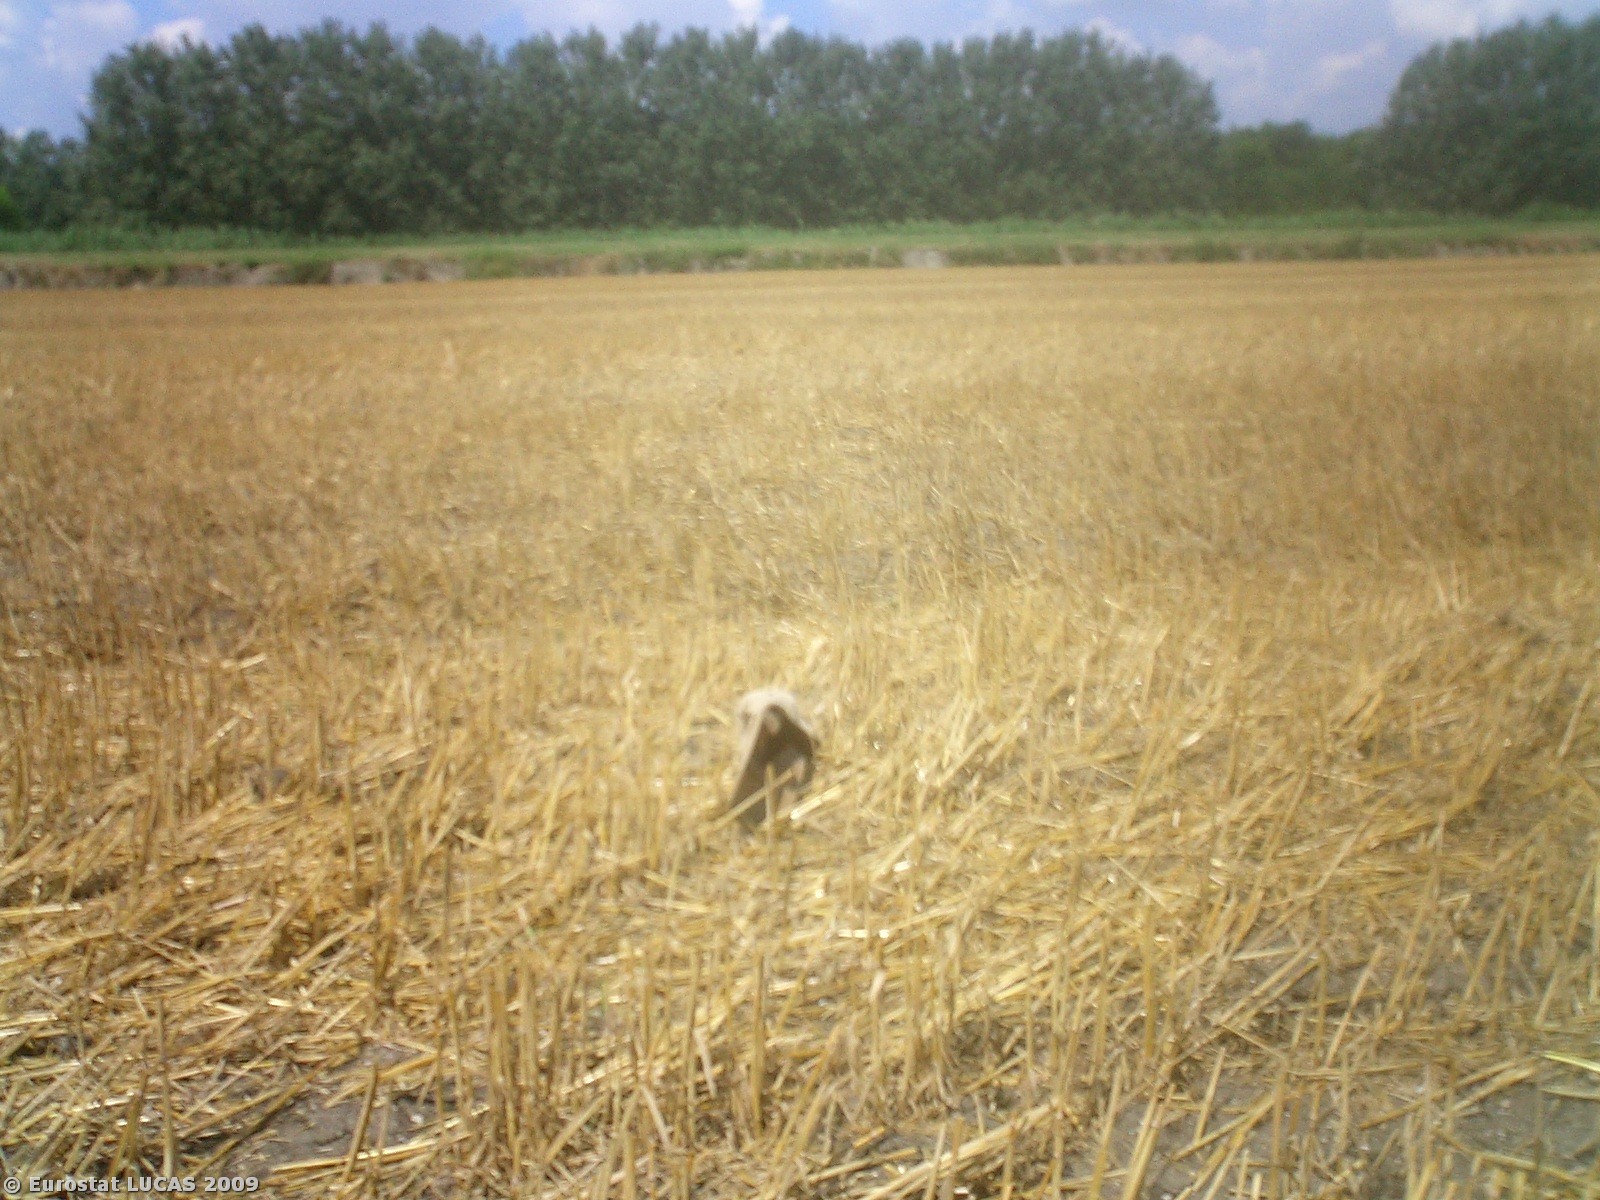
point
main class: Cropland
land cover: Common wheat
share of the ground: > 75 %
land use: Agriculture (excluding fallow land and kitchen gardens)
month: July
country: IT
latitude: 44.7091
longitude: 12.0533
